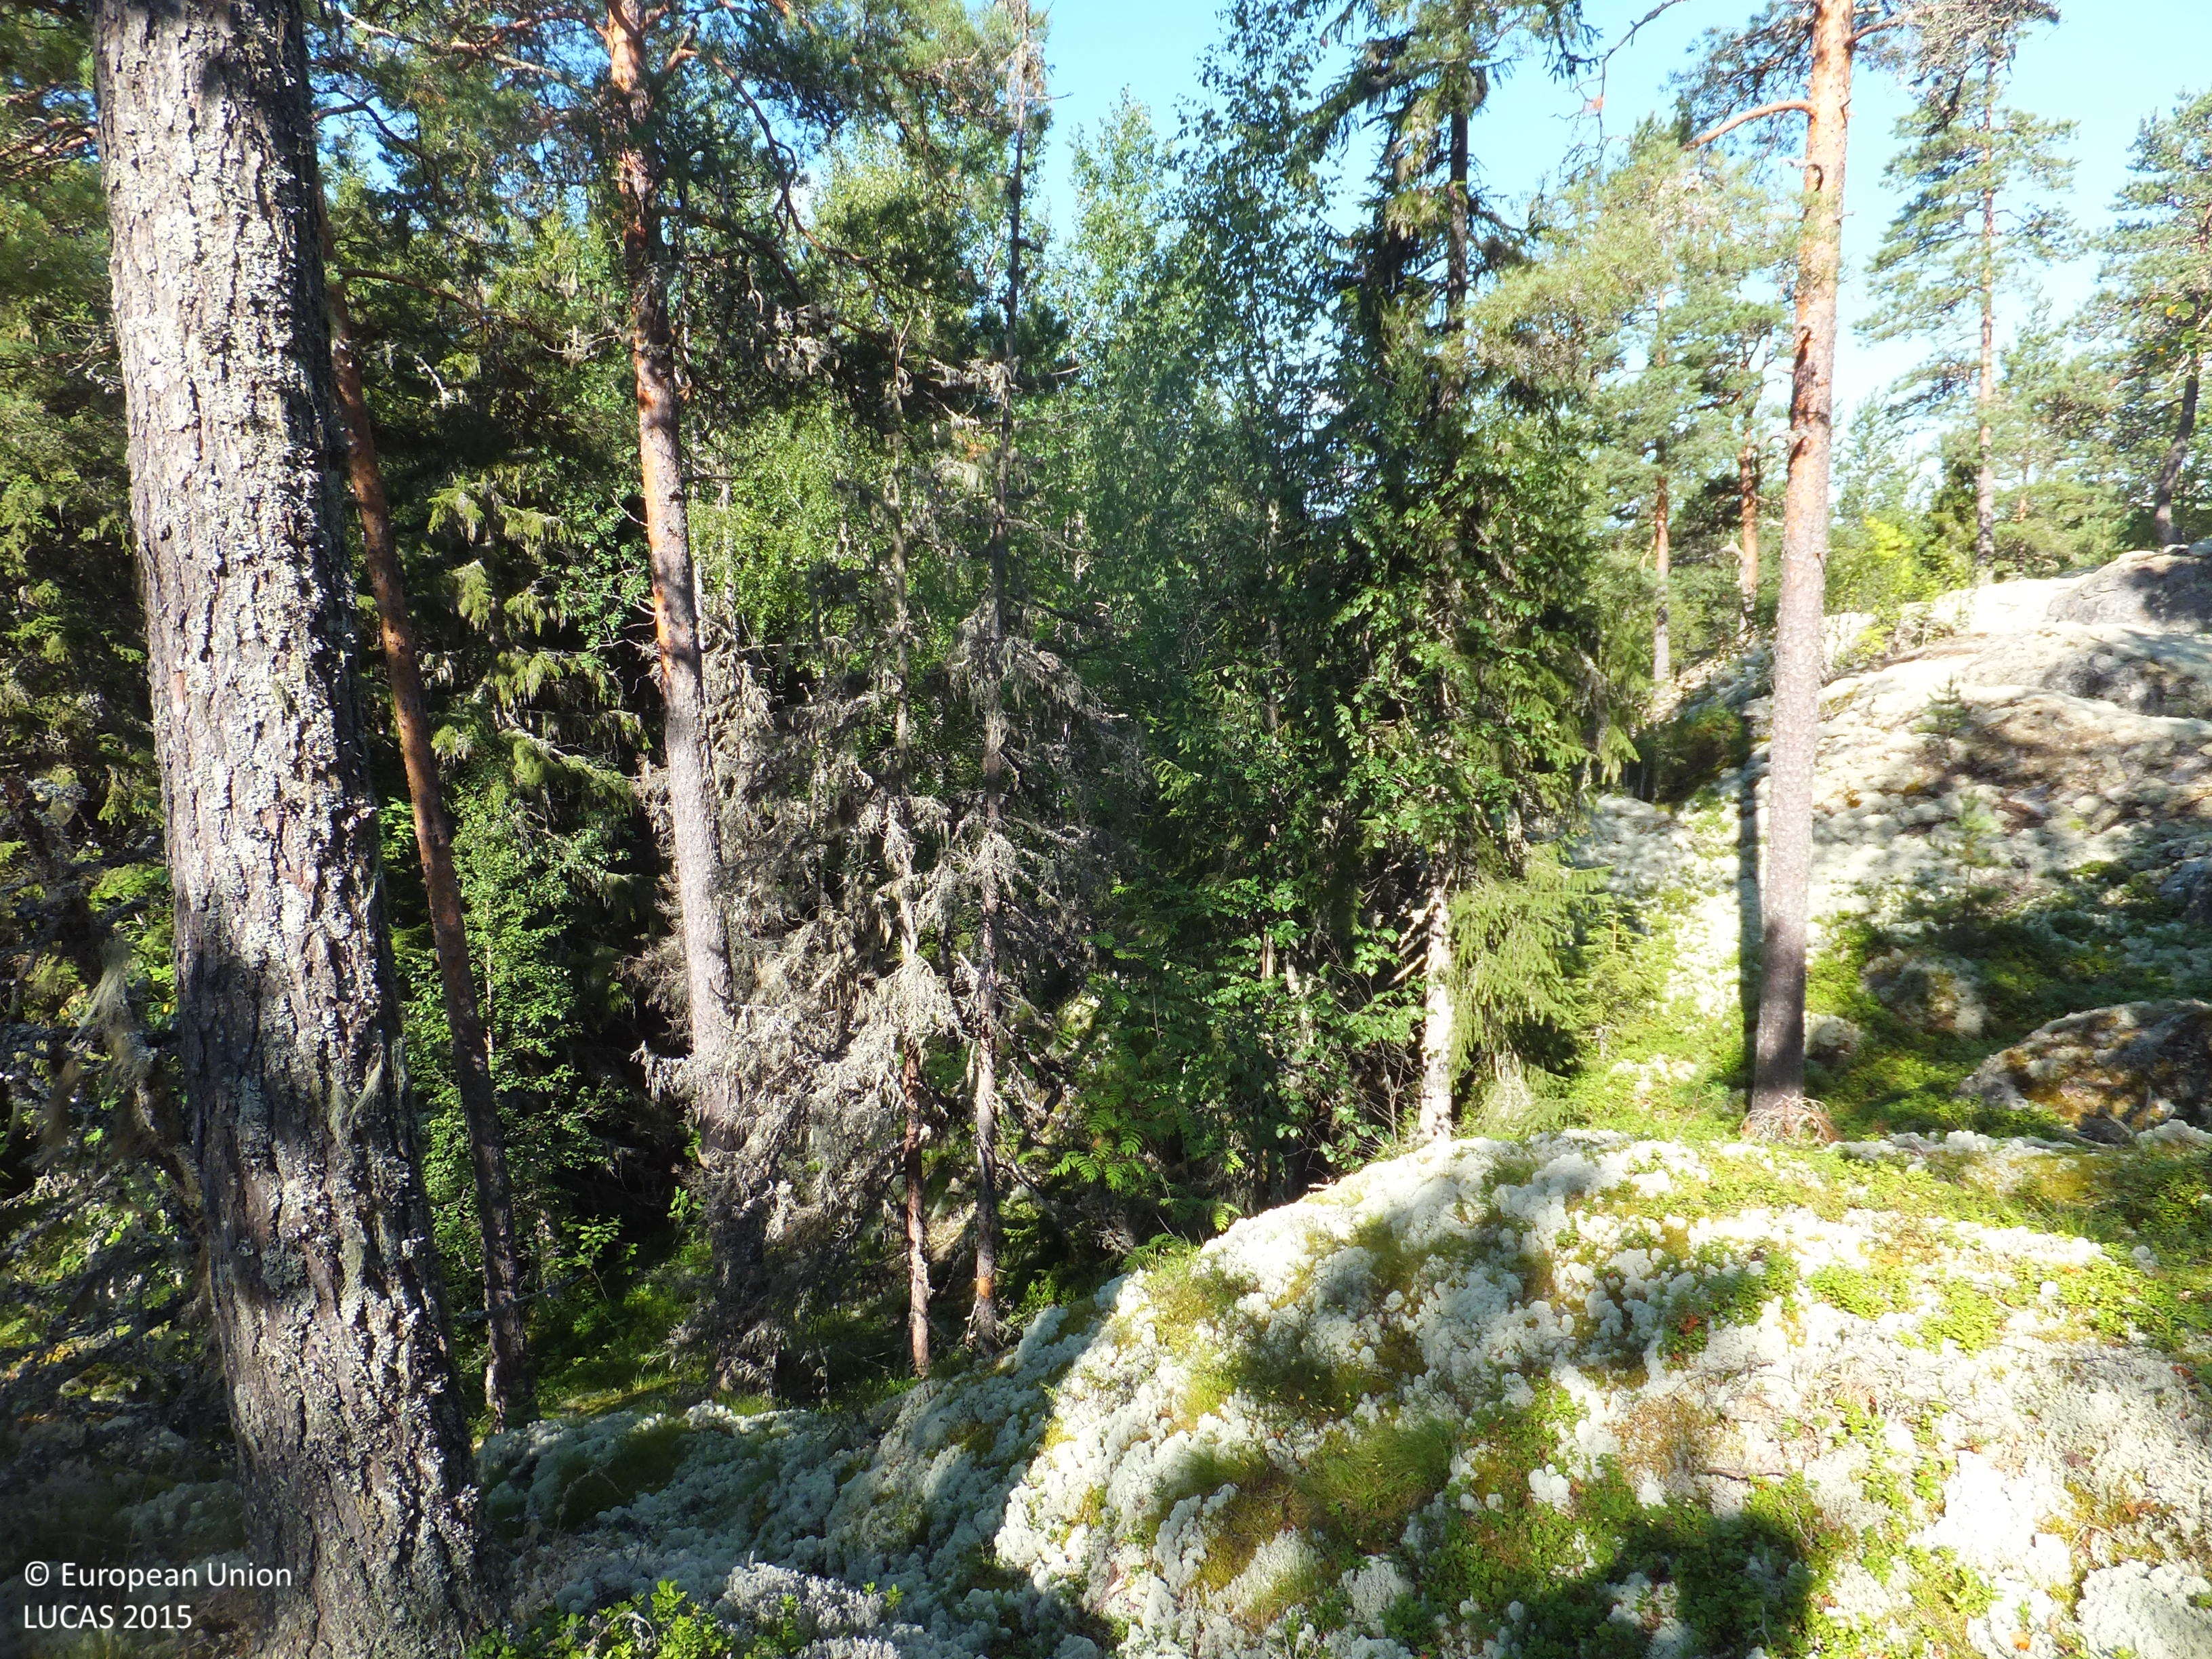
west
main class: Woodland
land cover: Pine dominated mixed woodland
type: boreal forest
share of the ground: 25 - 50 %
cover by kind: lichens and mosses 30 %, shrubs 25 %, coniferous forest trees 20 %, broadleaved forest trees 10 %, herbaceous plants 10 %, consolidated bare surface 5 %
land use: Forestry
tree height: > 5 m
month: August
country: FI
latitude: 63.1149
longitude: 22.0367
